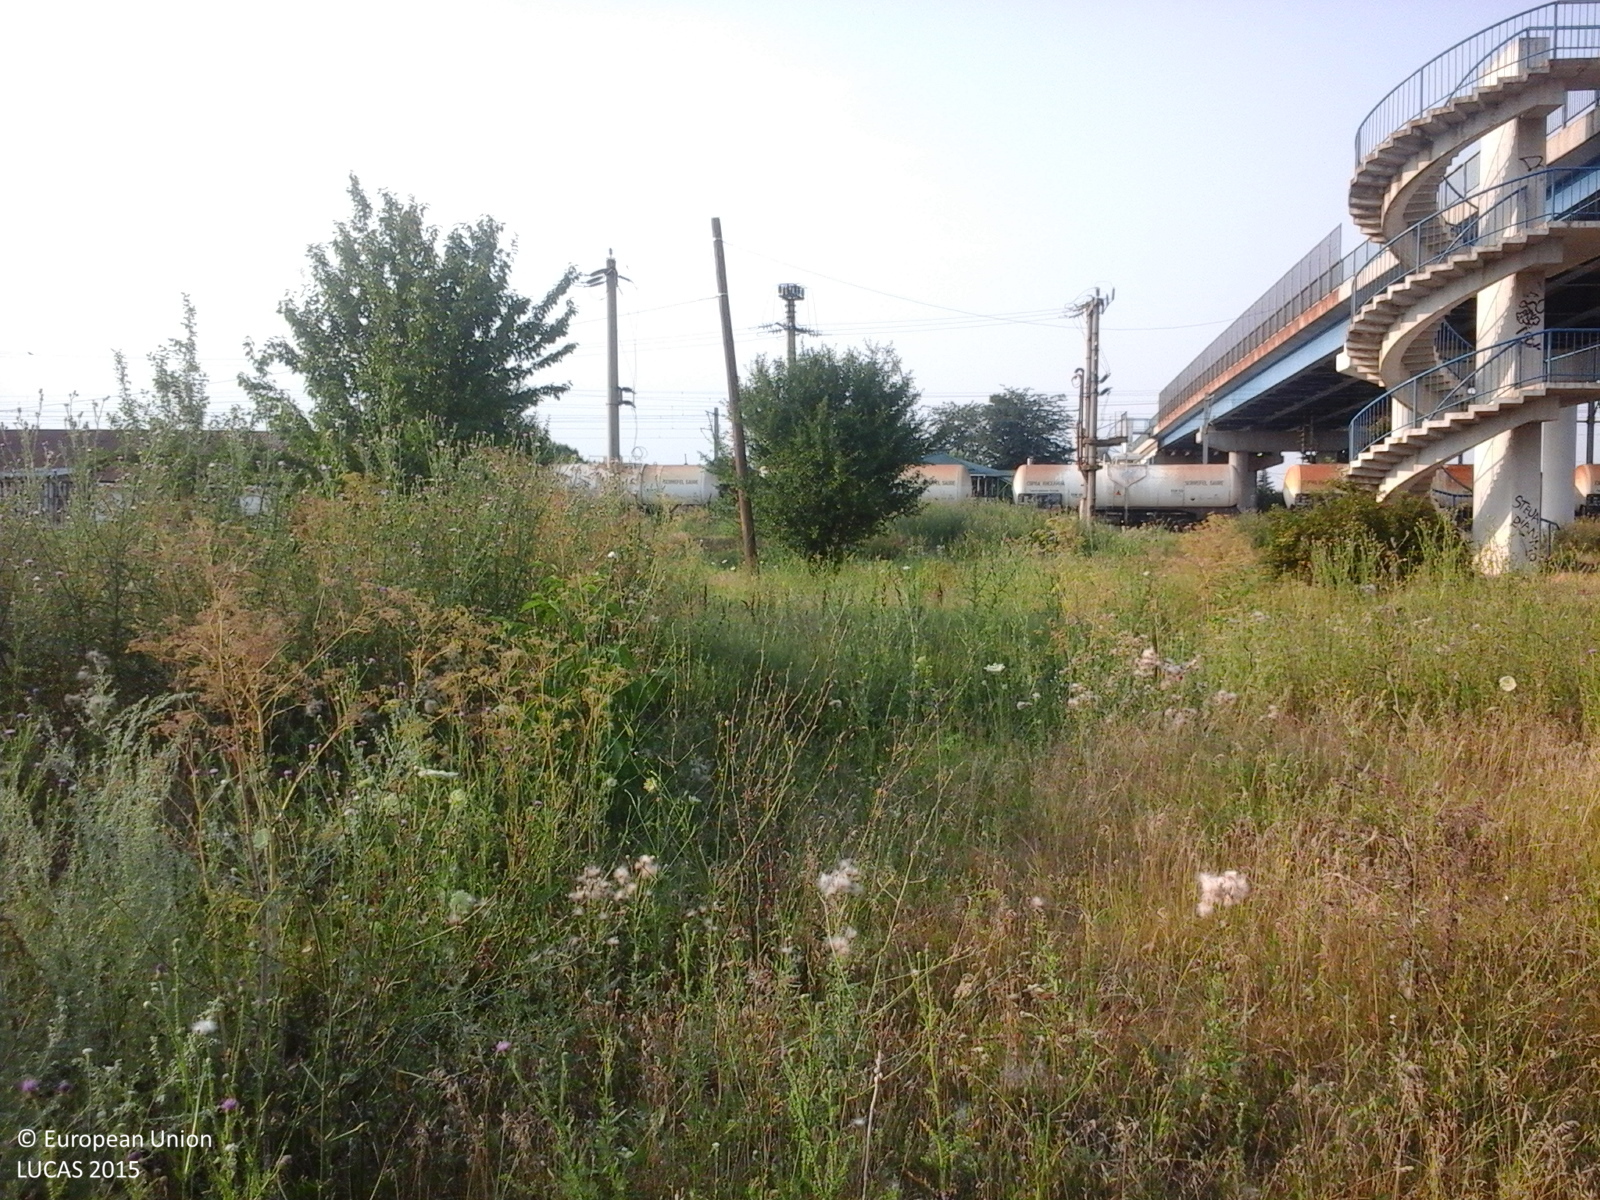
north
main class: Grassland
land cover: Spontaneously vegetated surfaces
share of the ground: > 75 %
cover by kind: herbaceous plants 100 %
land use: Semi-natural and natural areas not in use
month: July
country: RO
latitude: 44.4498
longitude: 26.5144
